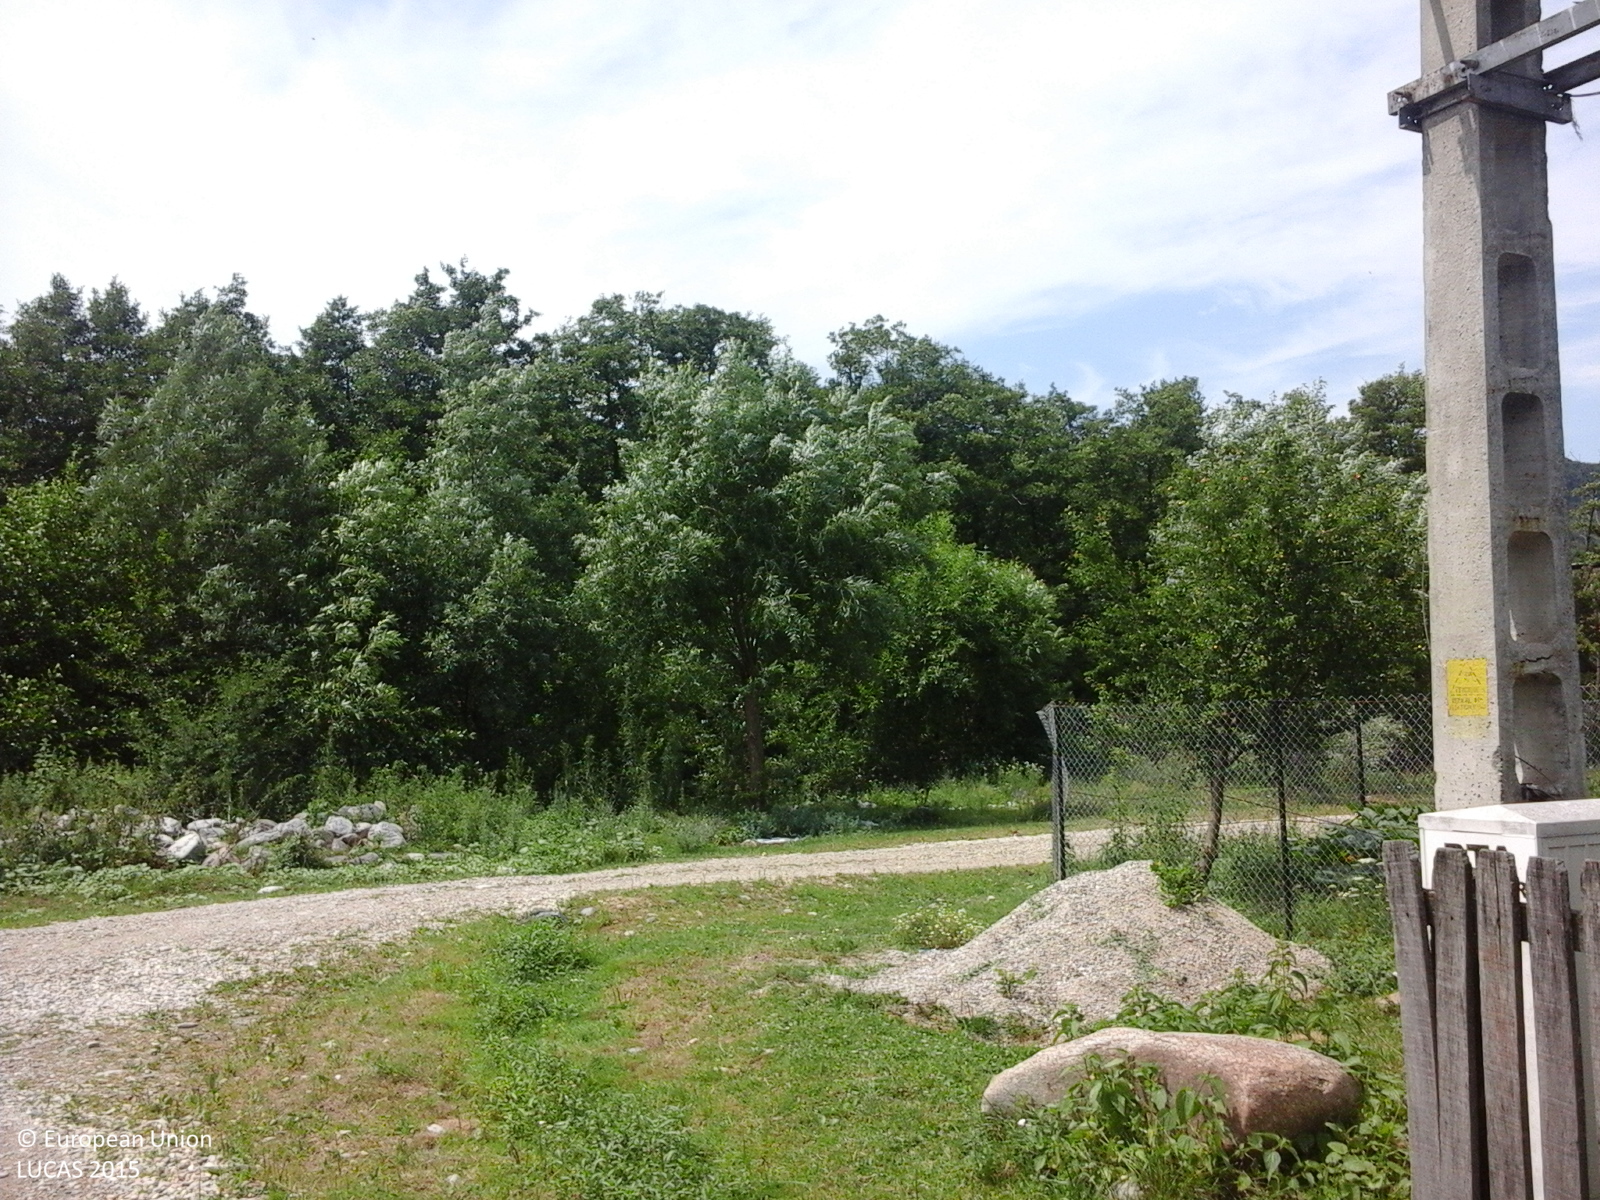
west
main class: Cropland
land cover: Potatoes
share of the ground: > 75 %
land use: Kitchen garden
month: July
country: RO
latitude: 45.2769
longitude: 24.8072
